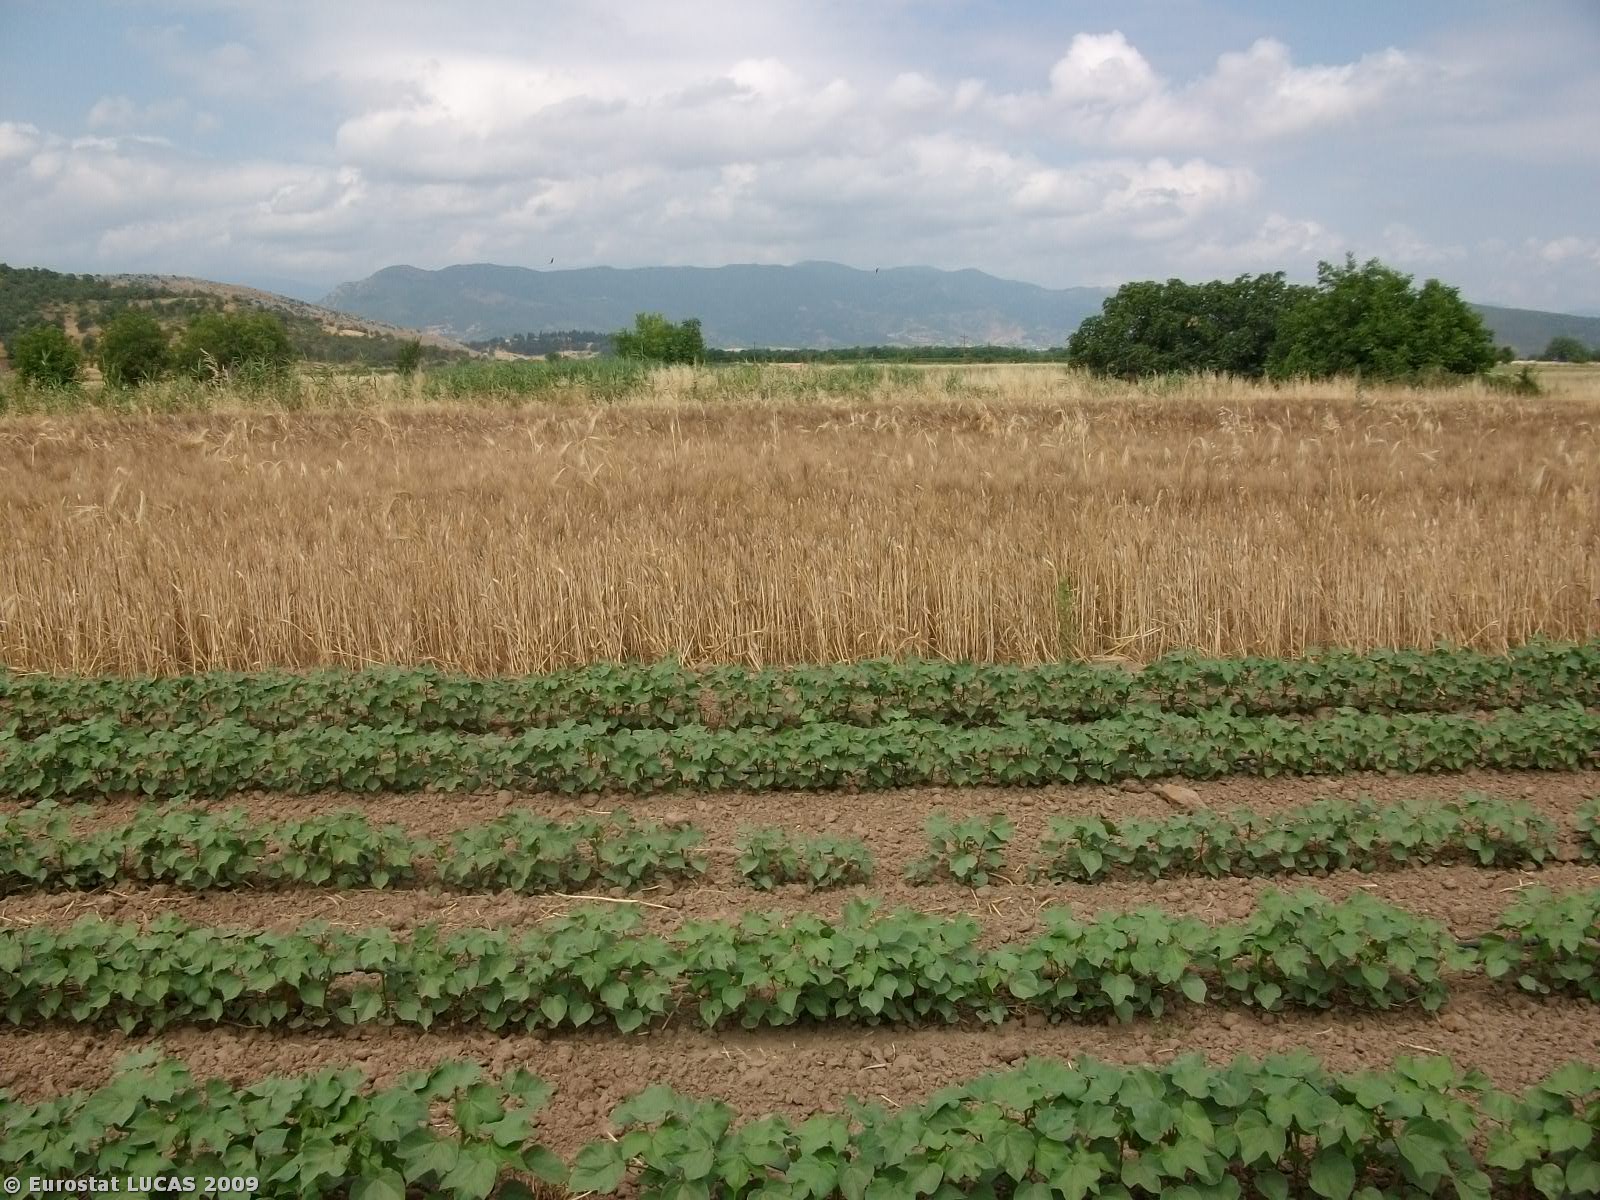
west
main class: Cropland
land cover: Cotton
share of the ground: 50 - 75 %
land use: Agriculture (excluding fallow land and kitchen gardens)
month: June
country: GR
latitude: 39.2803
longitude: 21.9333
